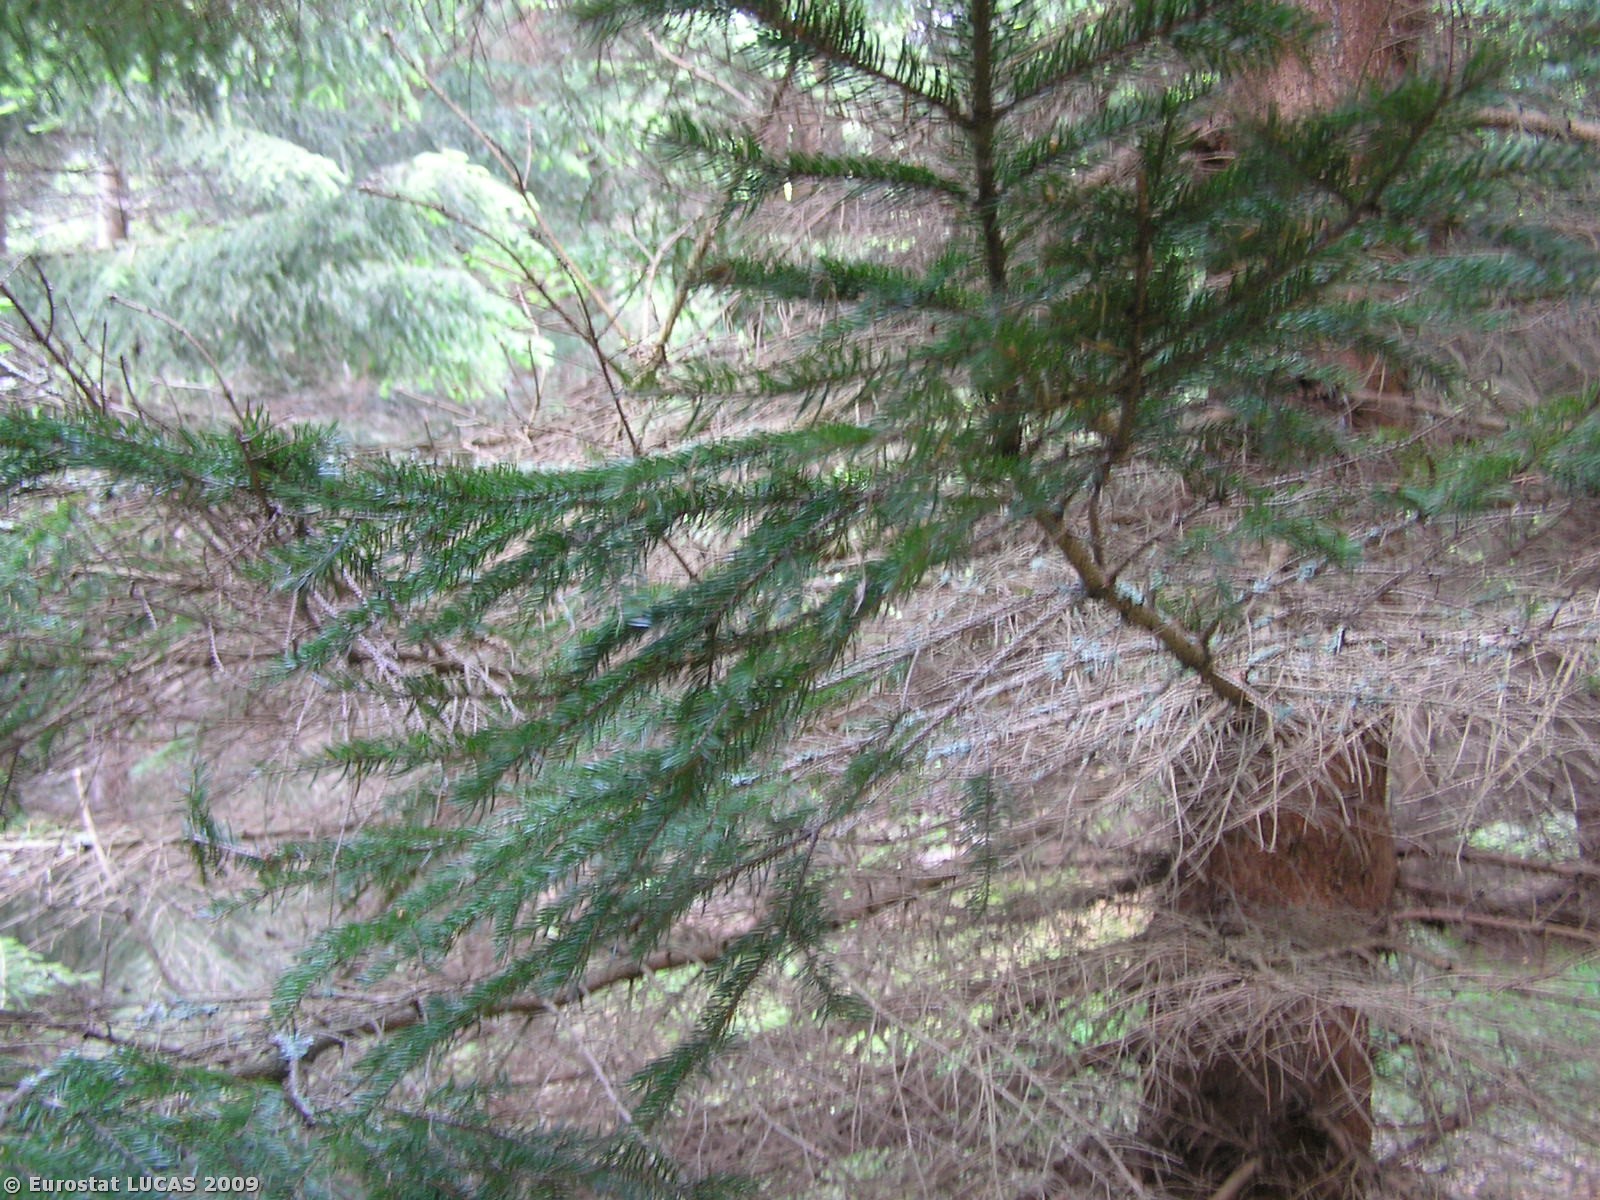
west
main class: Woodland
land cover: Mixed woodland
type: hemiboreal forest and nemoral coniferous forest and mixed broadleaved-coniferous forest
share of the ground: > 75 %
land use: Forestry
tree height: > 5 m
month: July
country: CZ
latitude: 50.0431
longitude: 17.2582
